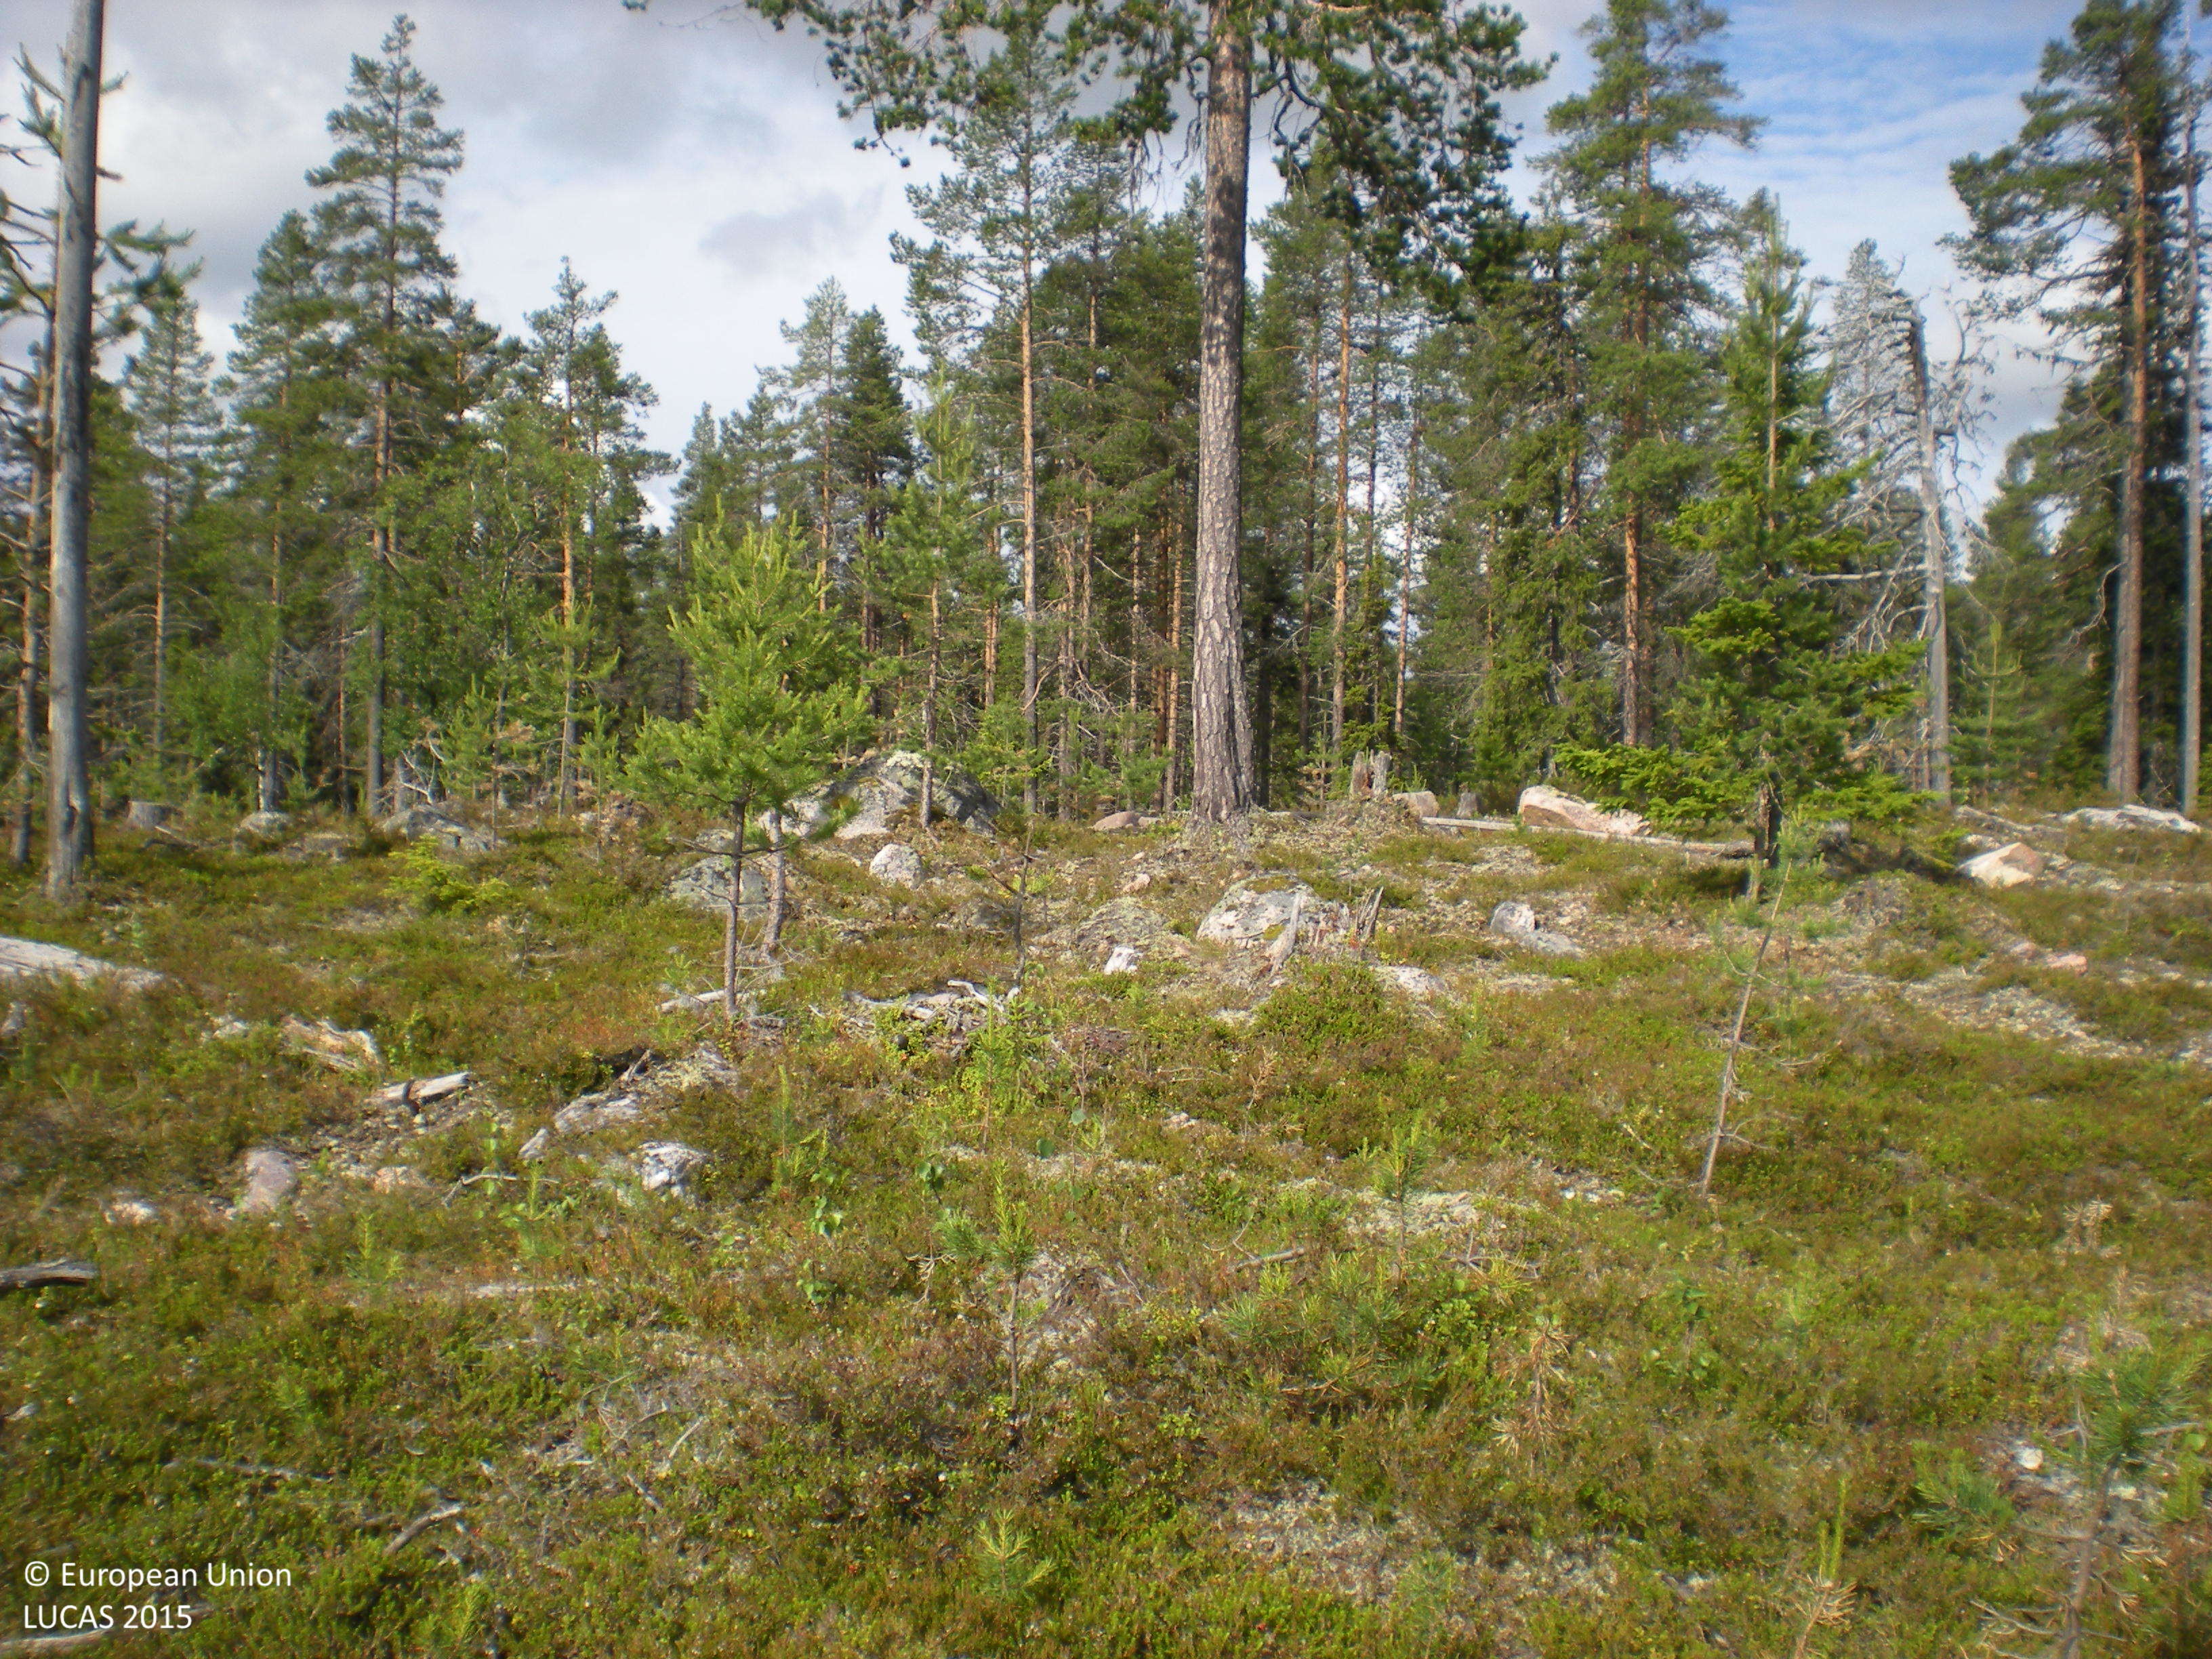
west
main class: Woodland
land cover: Pine dominated coniferous woodland
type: boreal forest
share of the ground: 10 - 25 %
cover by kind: shrubs 60 %, lichens and mosses 20 %, coniferous forest trees 10 %, consolidated bare surface 10 %
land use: Forestry
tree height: > 5 m
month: July
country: SE
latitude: 65.8000
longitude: 18.2868
